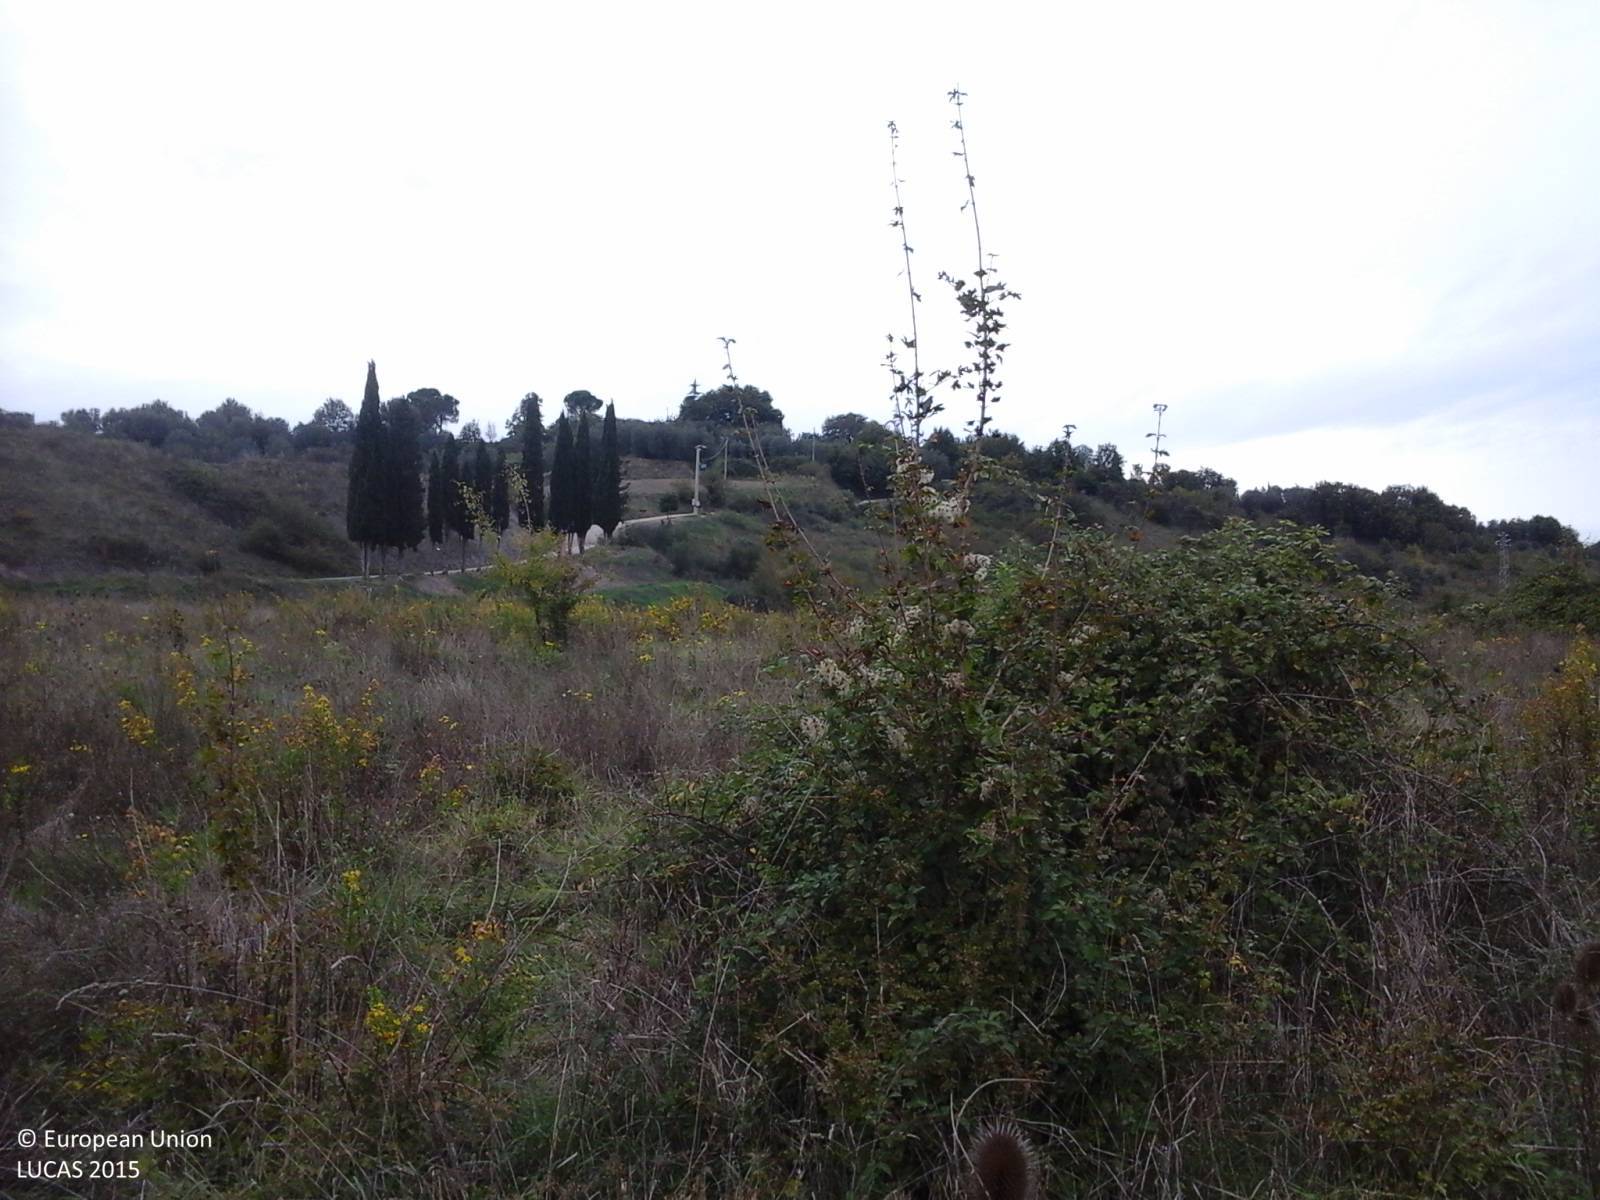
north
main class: Shrubland
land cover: Shrubland without tree cover
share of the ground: > 75 %
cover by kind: shrubs 90 %, herbaceous plants 10 %
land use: Abandoned areas
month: October
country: IT
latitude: 43.3098
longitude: 11.5859
